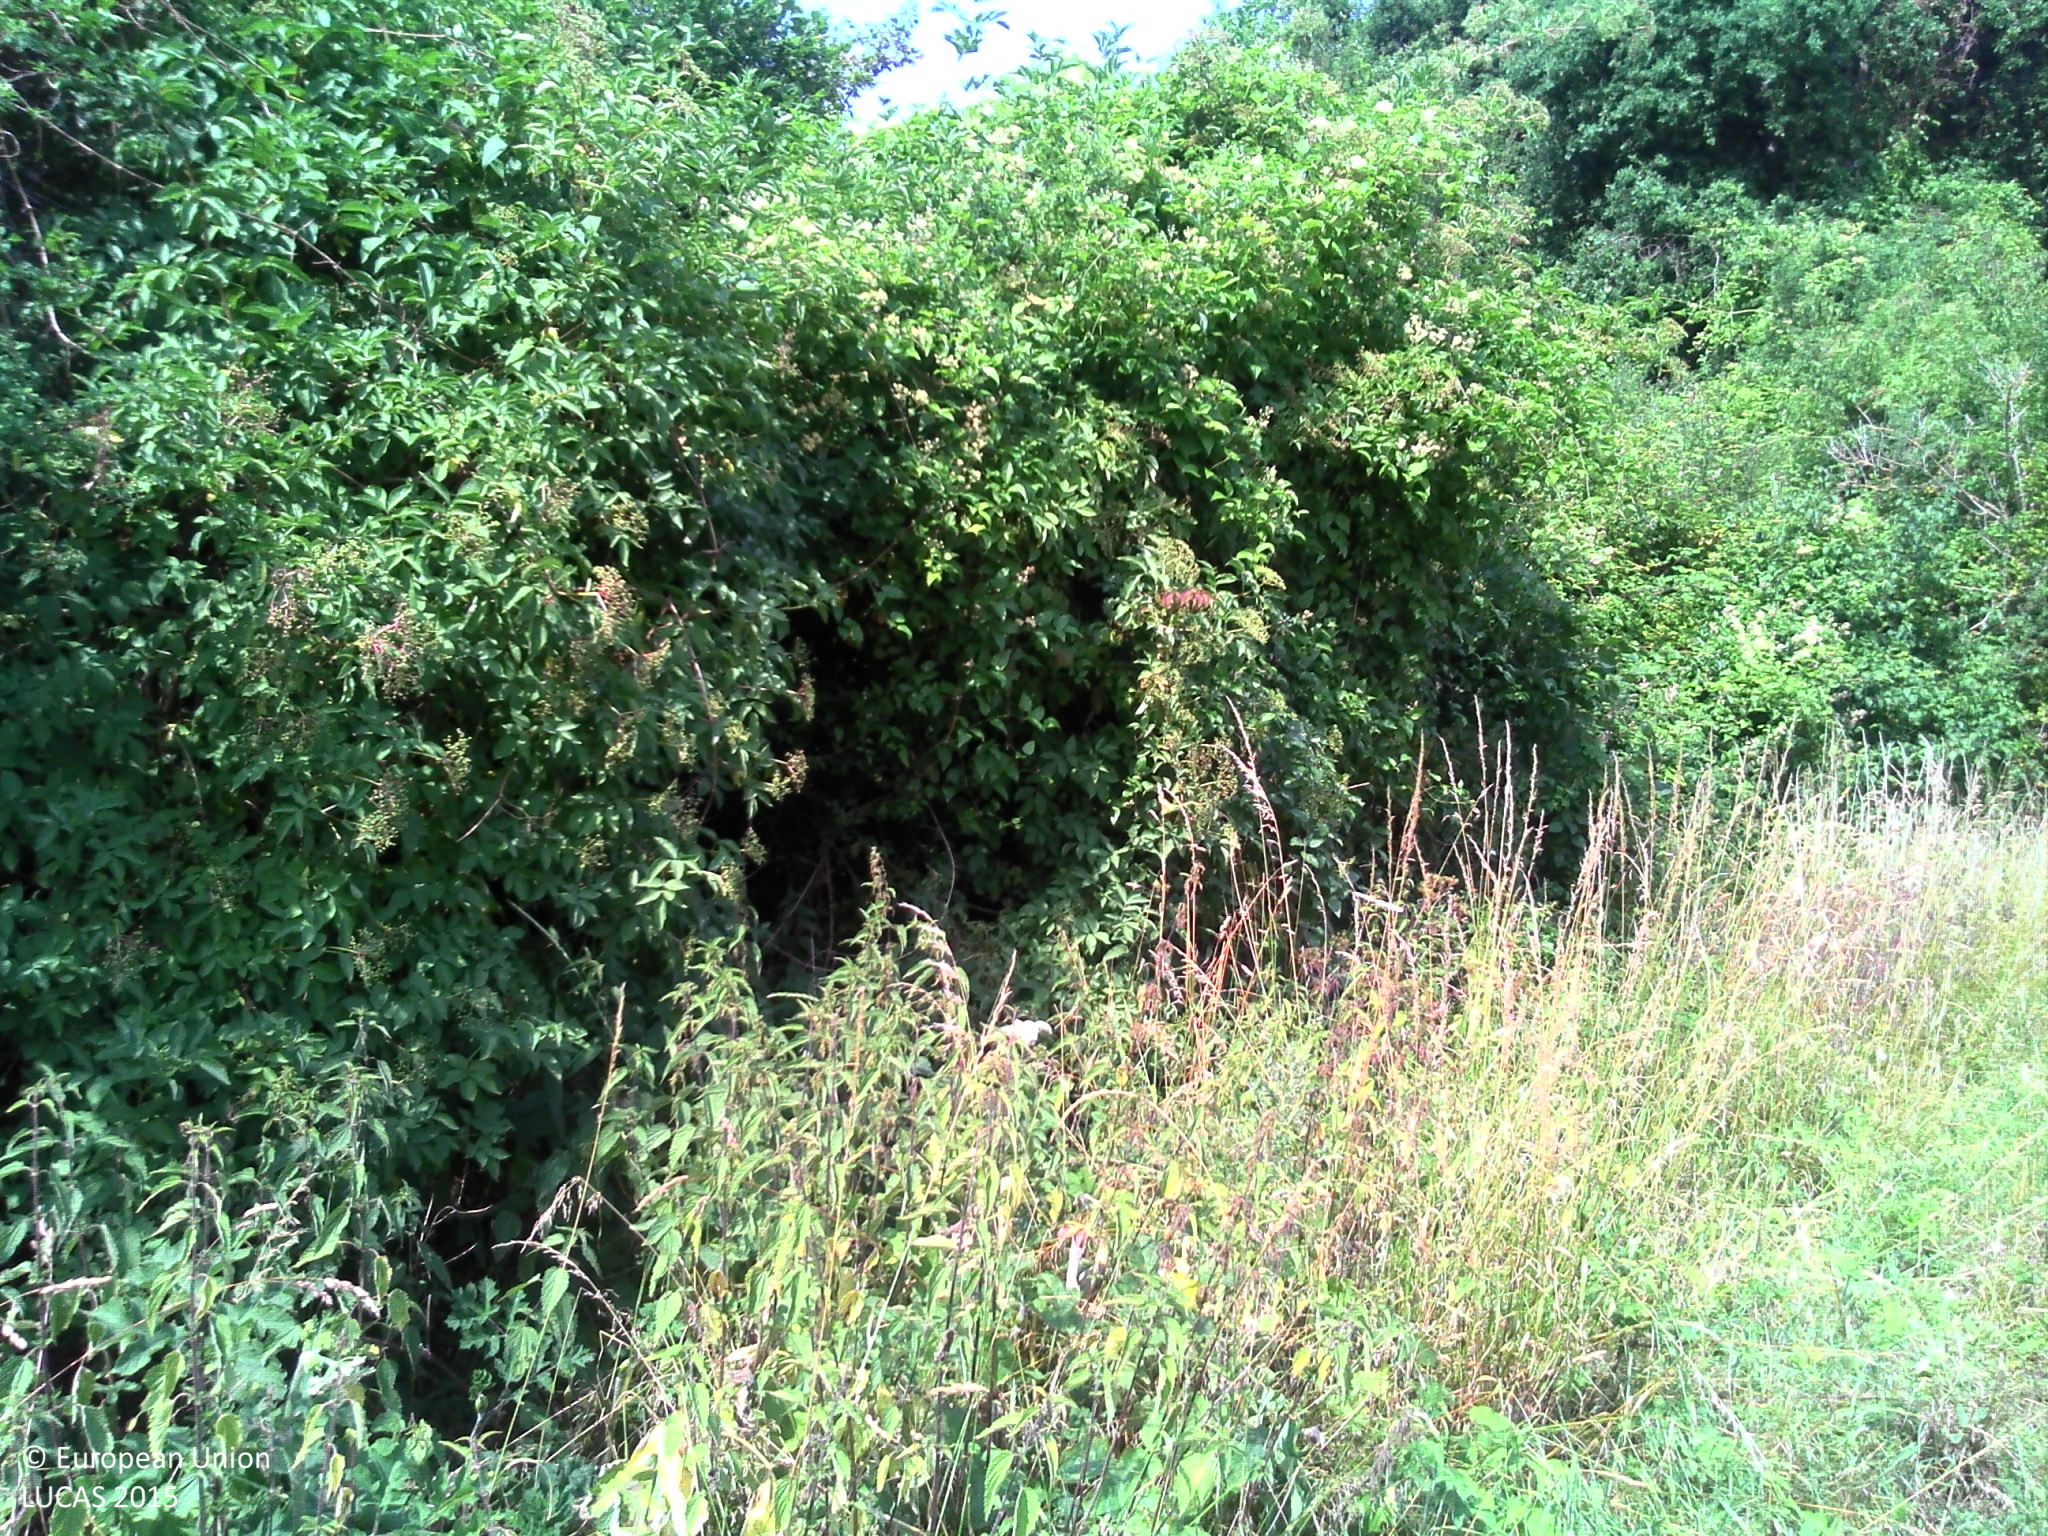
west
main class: Cropland
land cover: Rape and turnip rape
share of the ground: > 75 %
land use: Agriculture (excluding fallow land and kitchen gardens)
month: July
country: FR
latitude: 47.8249
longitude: 2.7927
